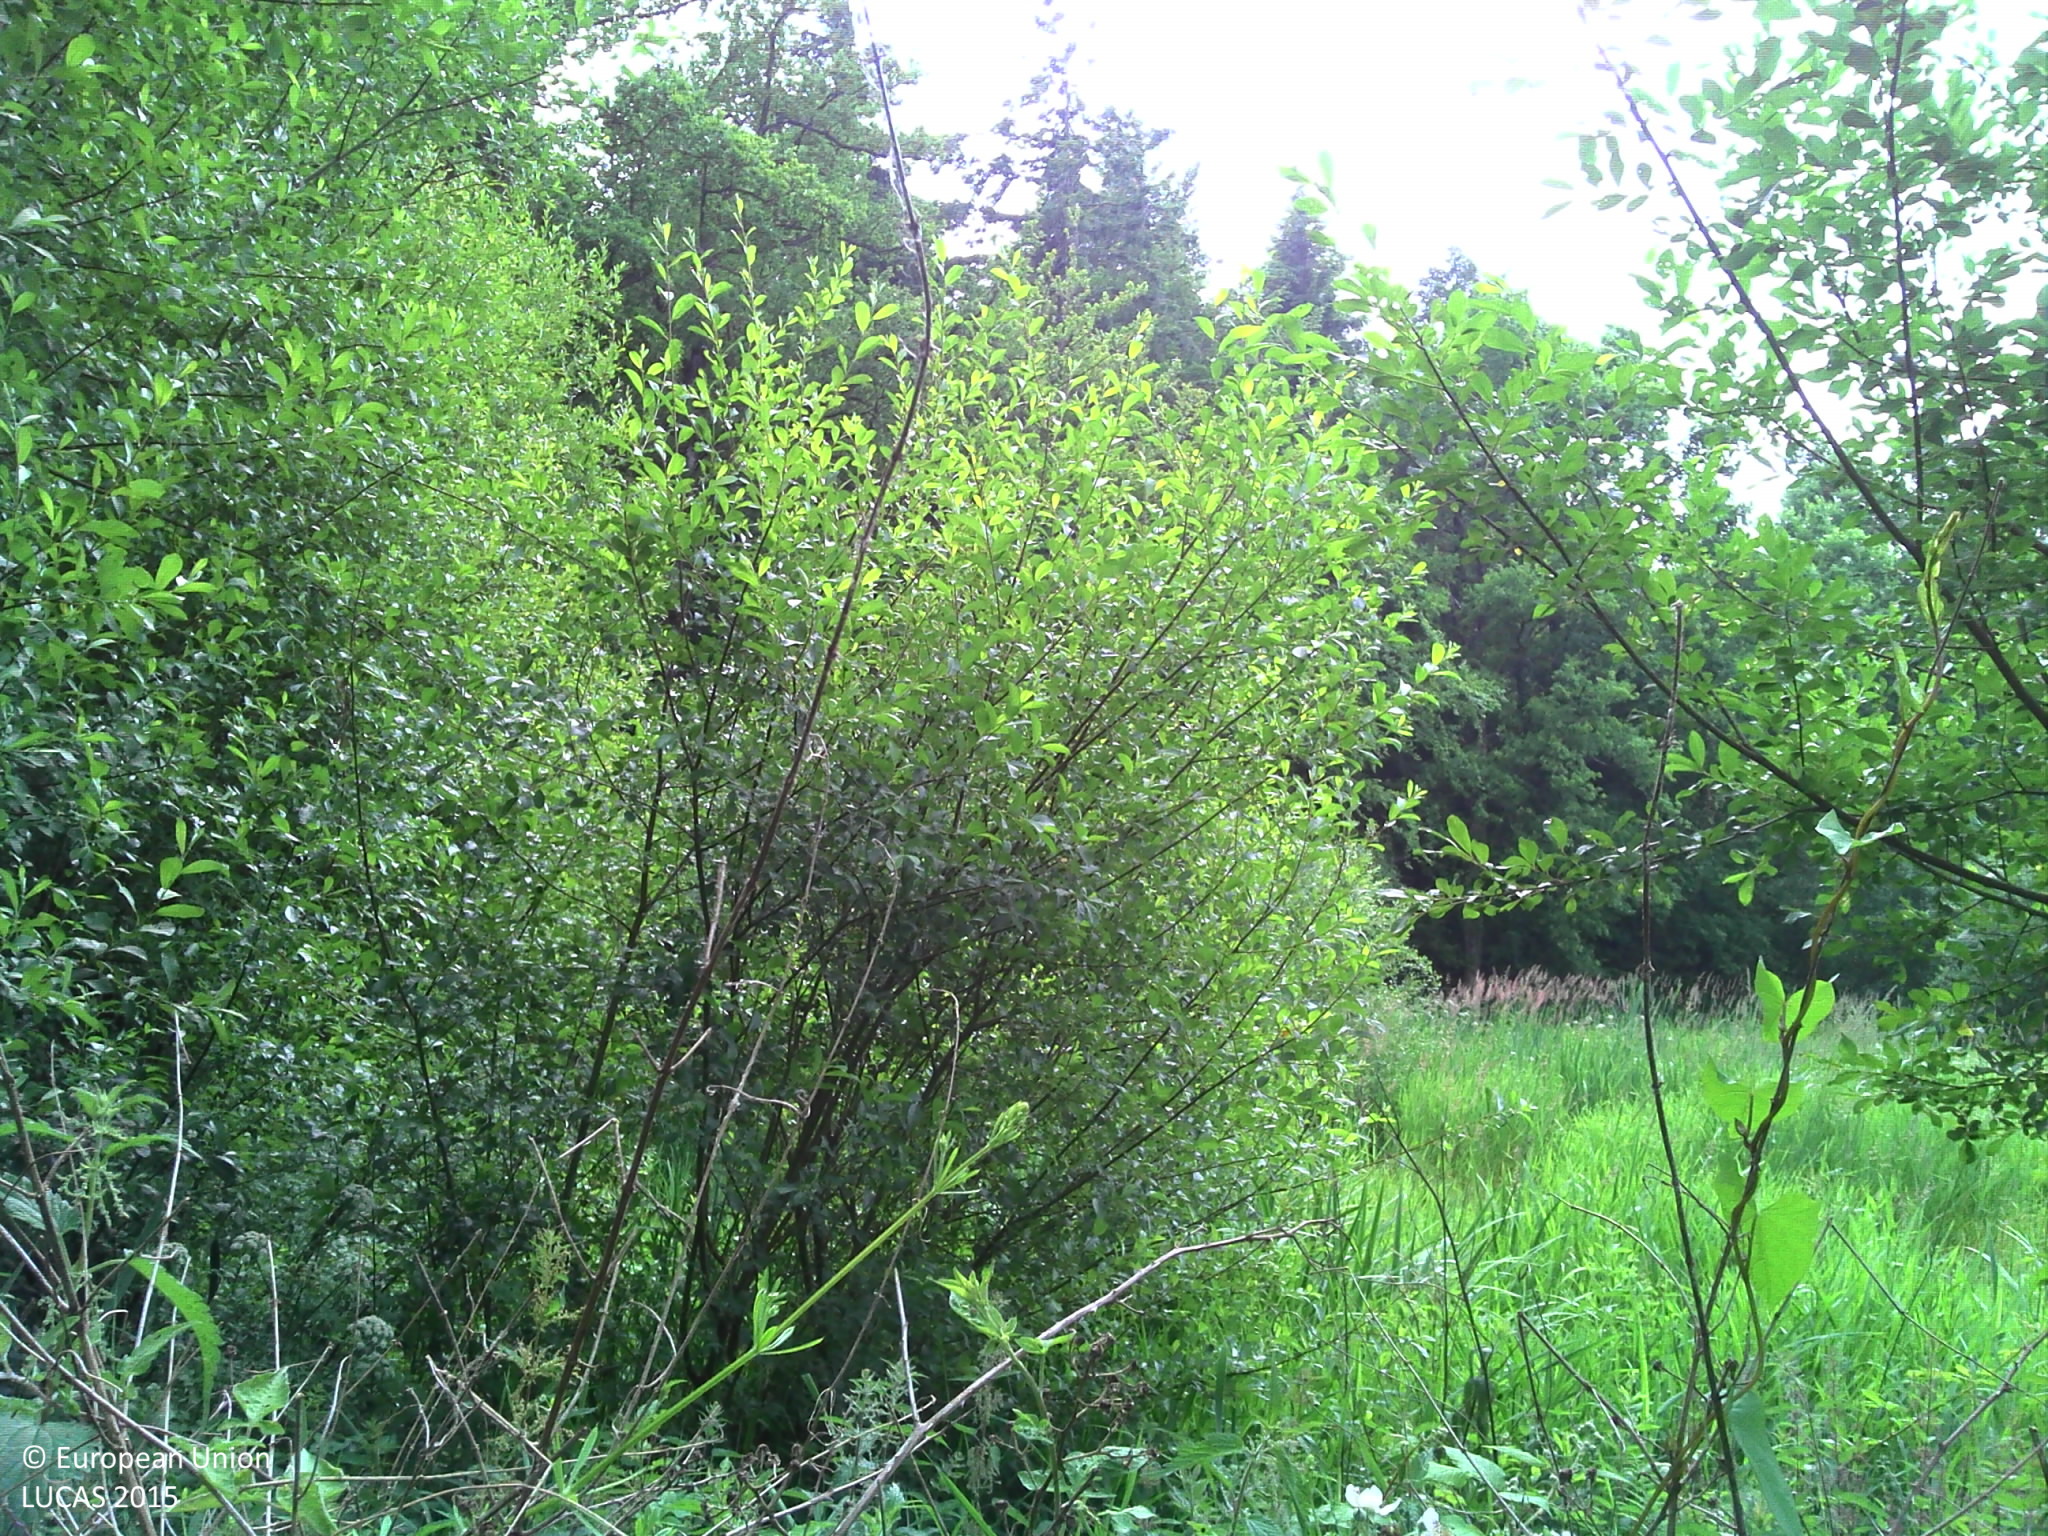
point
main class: Woodland
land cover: Spruce dominated mixed woodland
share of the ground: > 75 %
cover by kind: broadleaved forest trees 55 %, coniferous forest trees 40 %, herbaceous plants 5 %
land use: Semi-natural and natural areas not in use
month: June
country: FR
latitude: 48.4861
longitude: -1.7265
